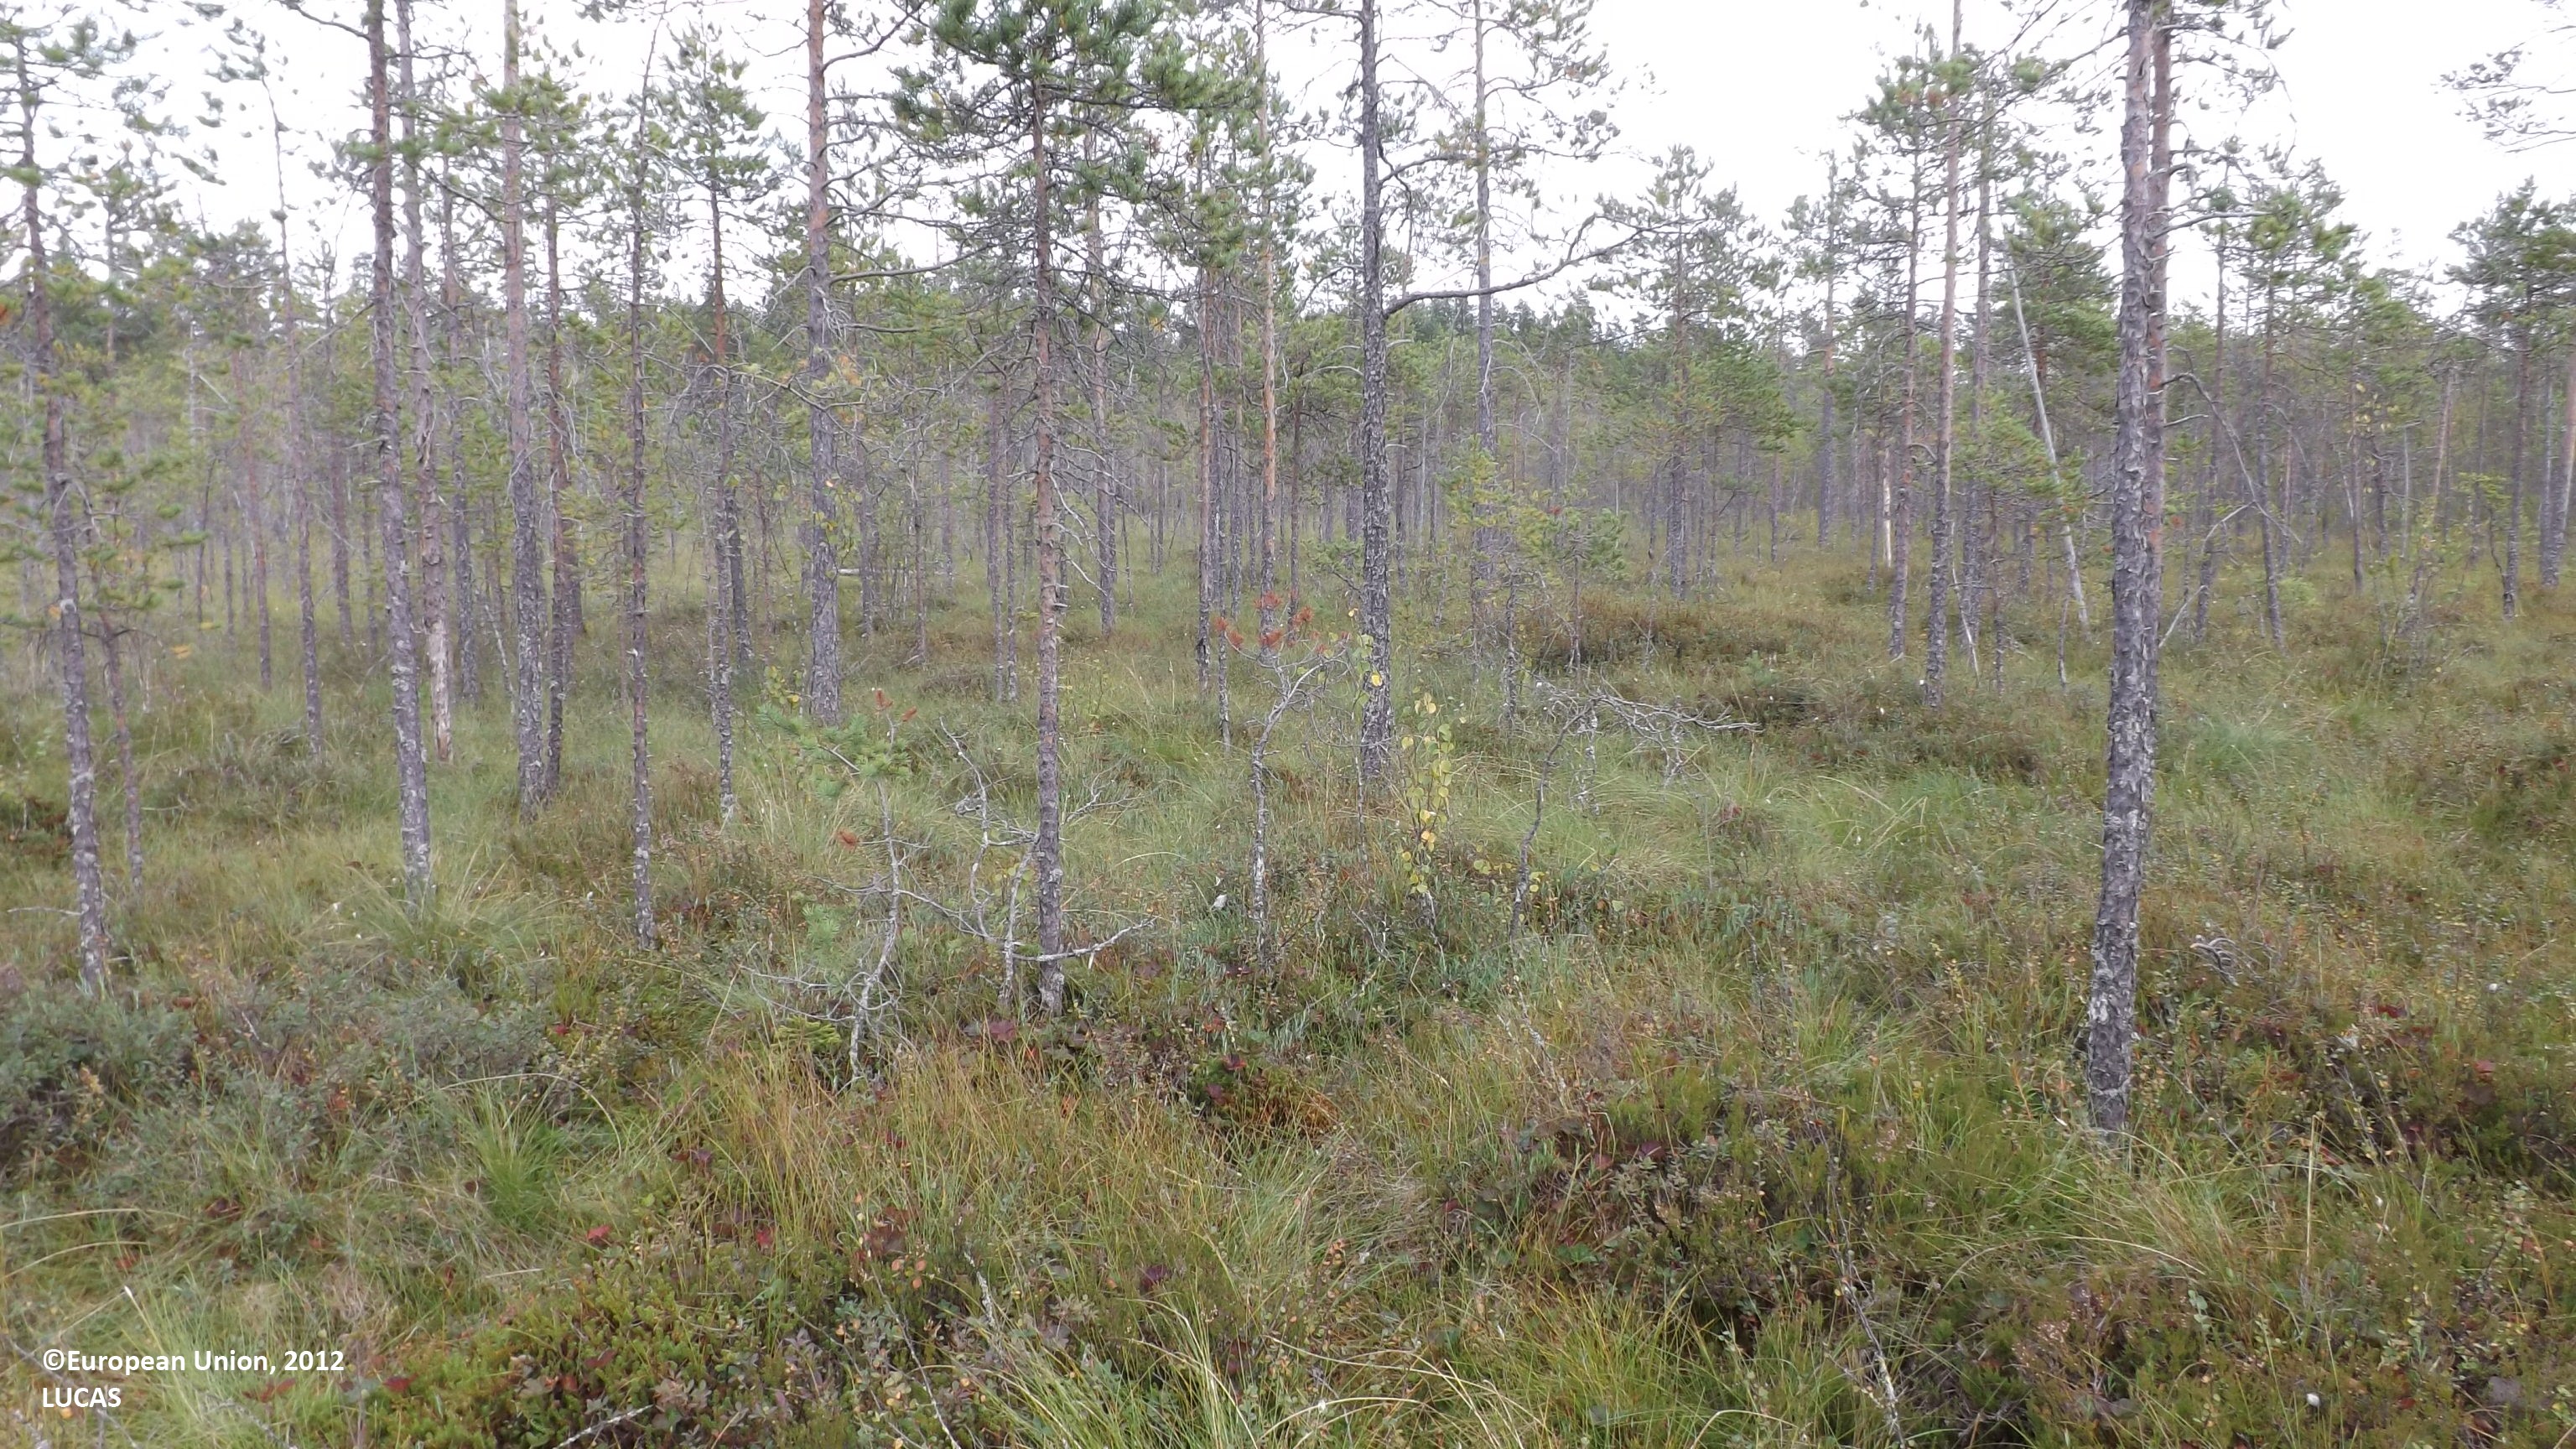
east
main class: Woodland
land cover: Pine dominated coniferous woodland
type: mire and swamp forests
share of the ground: 10 - 25 %
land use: Semi-natural and natural areas not in use
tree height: > 5 m
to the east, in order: Pine dominated coniferous woodland; Pine dominated mixed woodland; Pine dominated coniferous woodland; Pine dominated mixed woodland; Other mixed woodland; Pine dominated mixed woodland
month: August
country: FI
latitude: 63.7839
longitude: 24.0892
